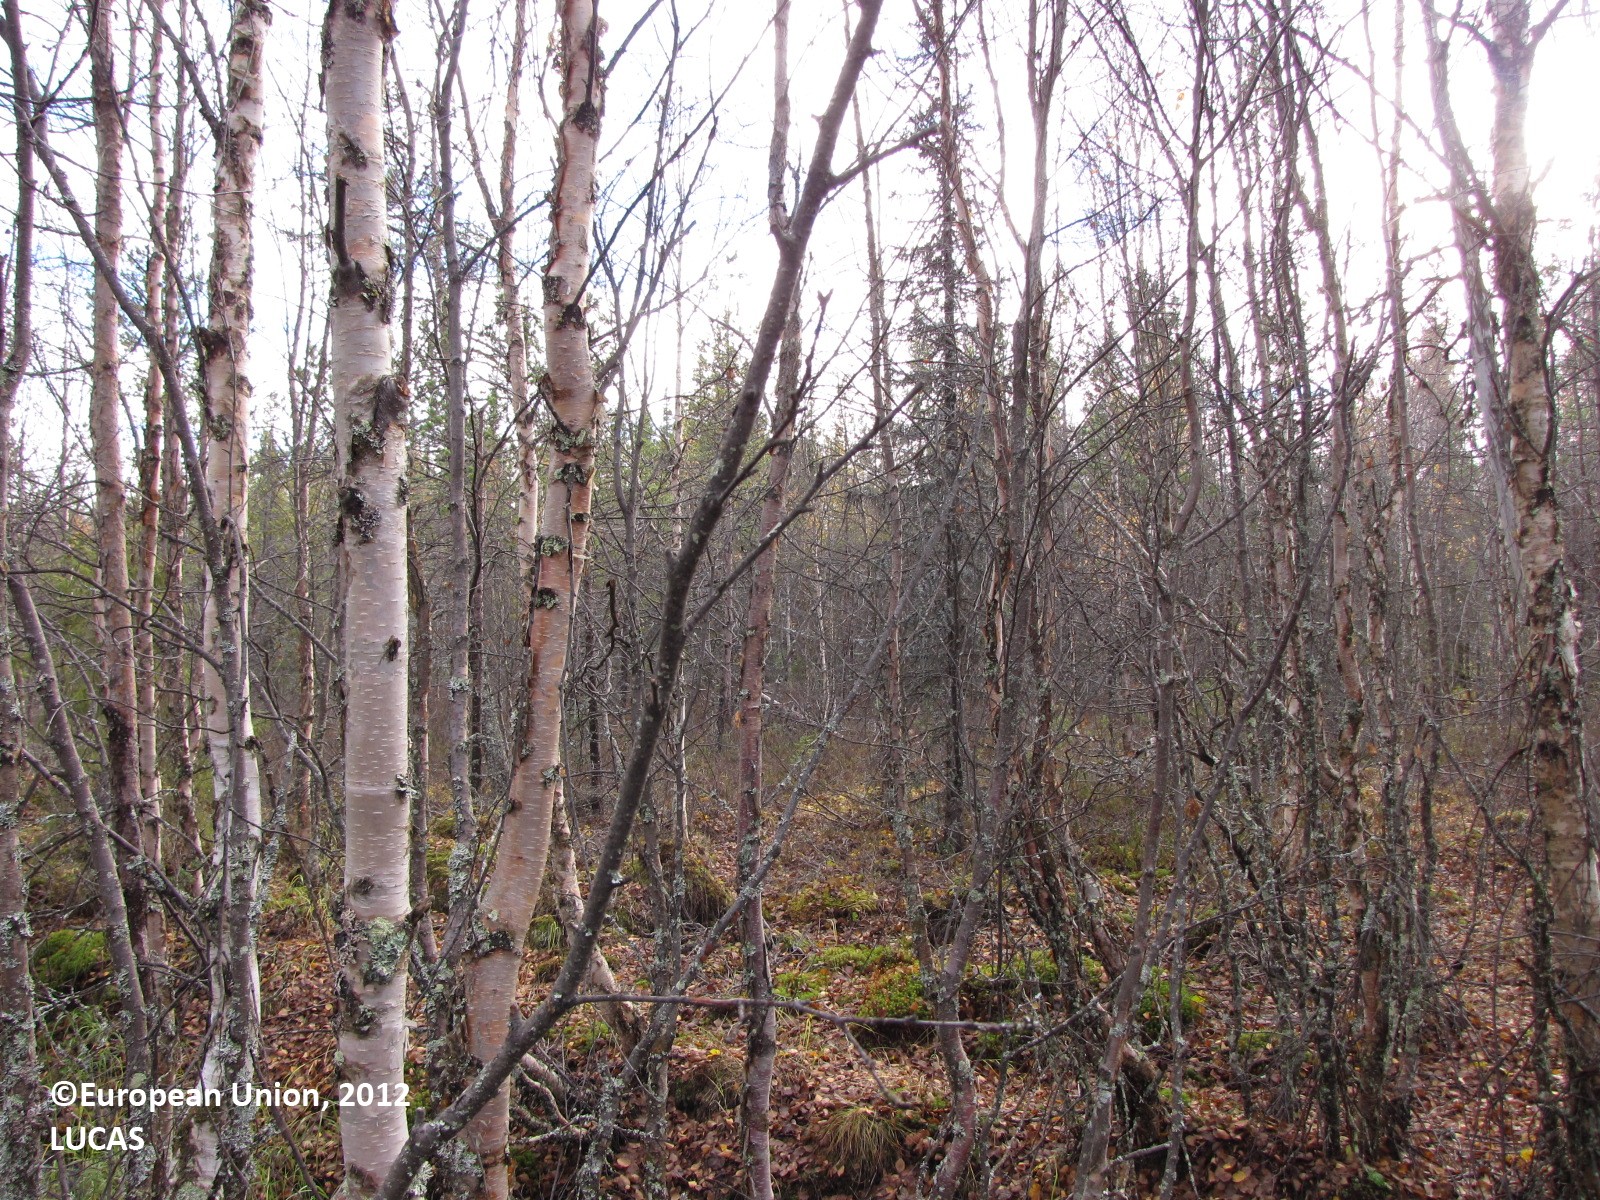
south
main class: Woodland
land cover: Broadleaved woodland
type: boreal forest
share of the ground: > 75 %
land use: Forestry
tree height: > 5 m
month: September
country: FI
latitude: 67.4781
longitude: 25.1319
